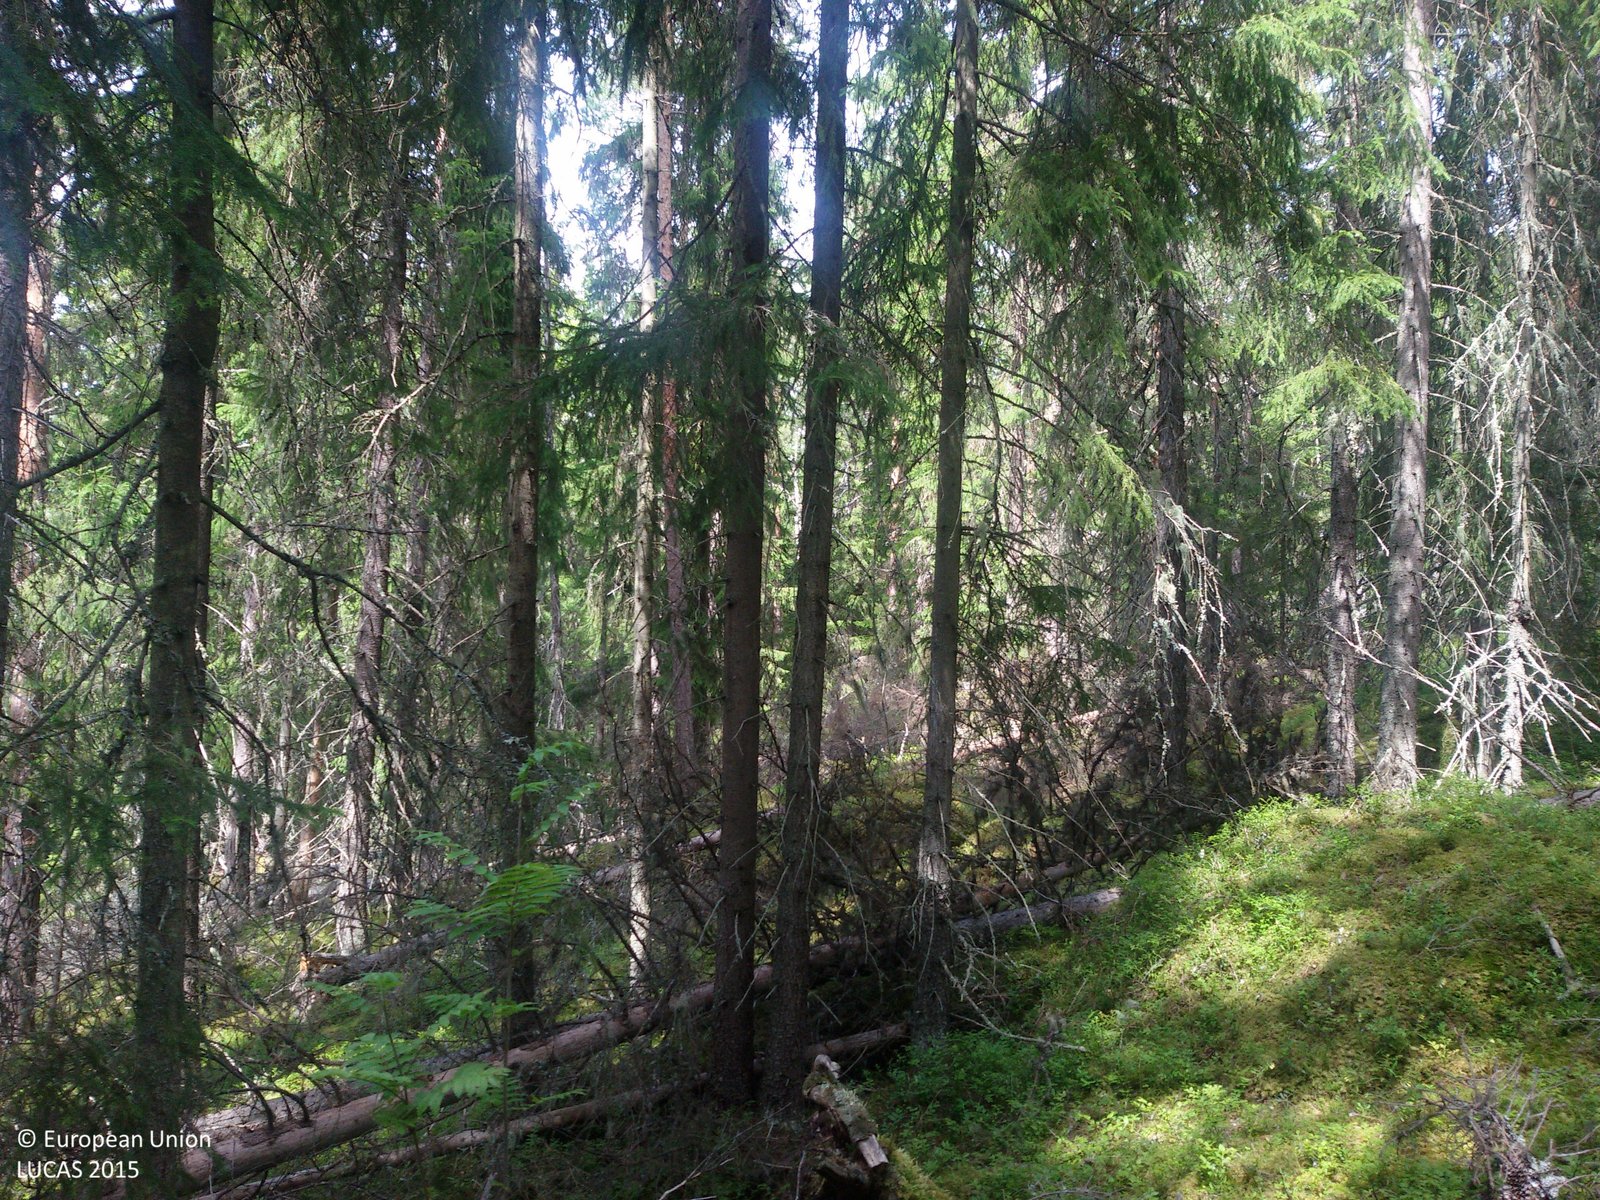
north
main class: Woodland
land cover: Spruce dominated coniferous woodland
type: boreal forest
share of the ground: > 75 %
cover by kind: coniferous forest trees 70 %, herbaceous plants 15 %, broadleaved forest trees 10 %, lichens and mosses 5 %
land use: Forestry
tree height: > 5 m
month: July
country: SE
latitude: 60.4485
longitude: 15.6045
